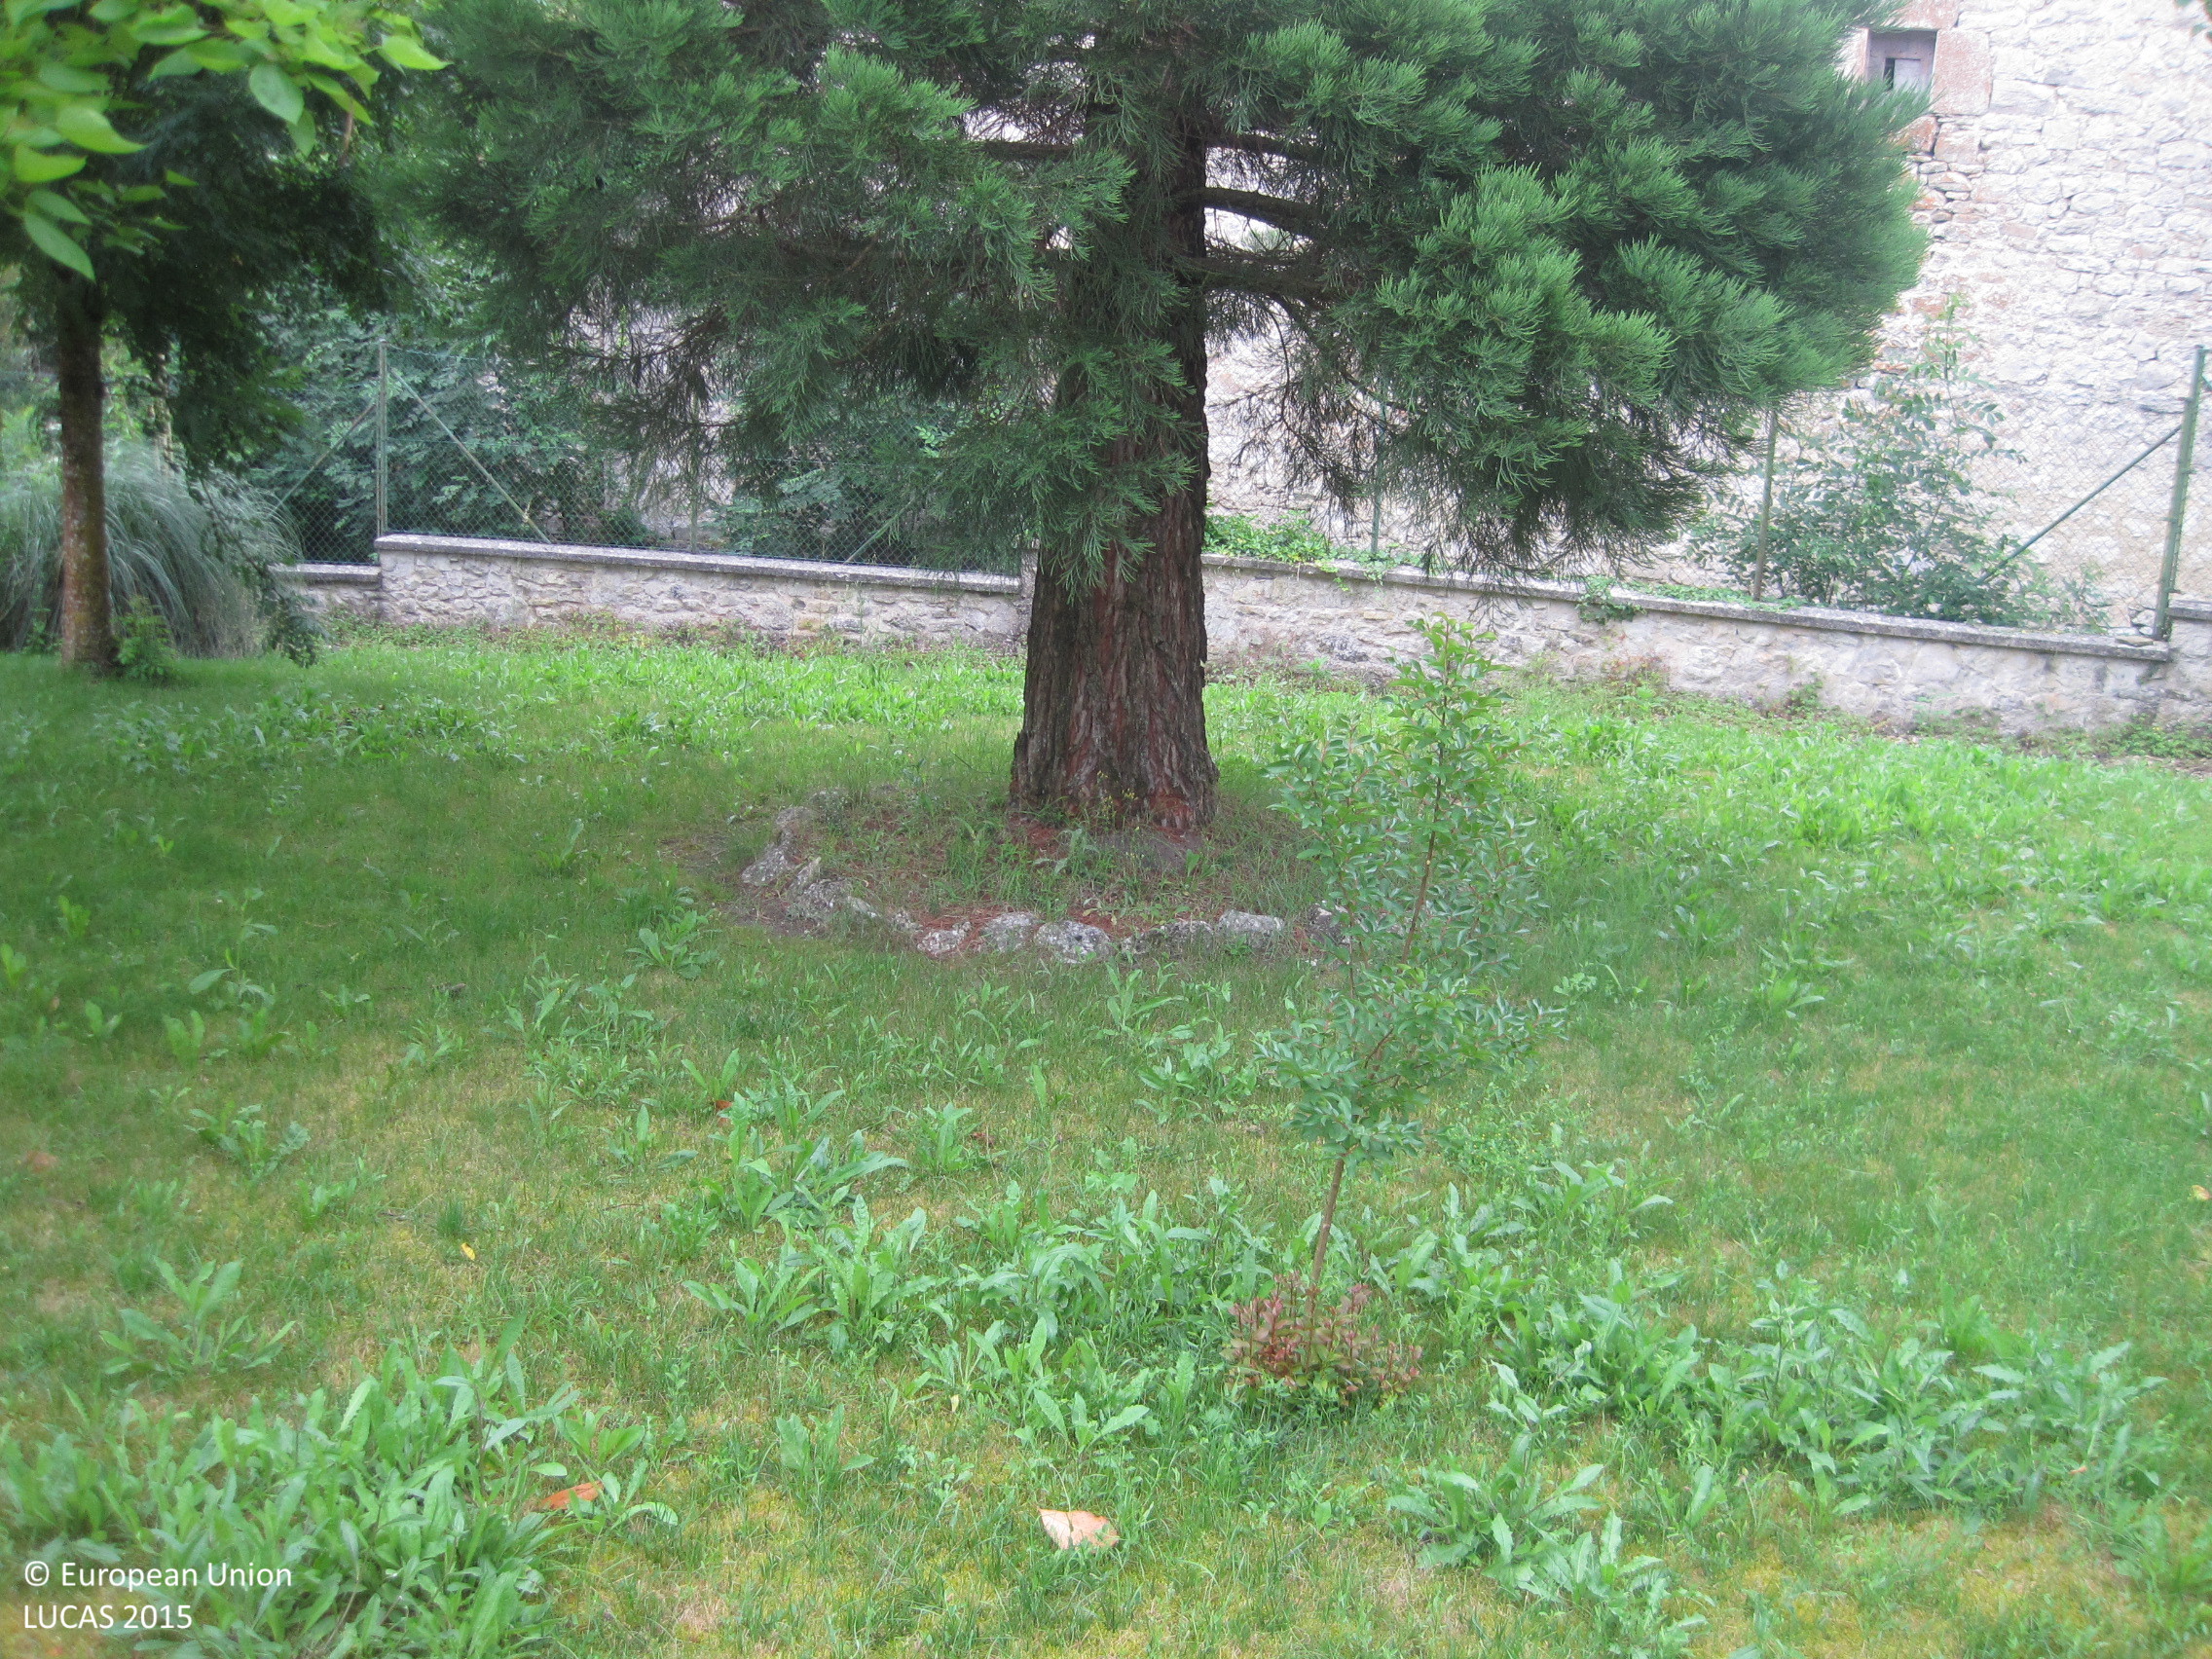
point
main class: Woodland
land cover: Broadleaved woodland
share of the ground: > 75 %
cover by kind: broadleaved forest trees 60 %, herbaceous plants 40 %
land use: Residential
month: June
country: ES
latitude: 42.9222
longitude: -1.6915
